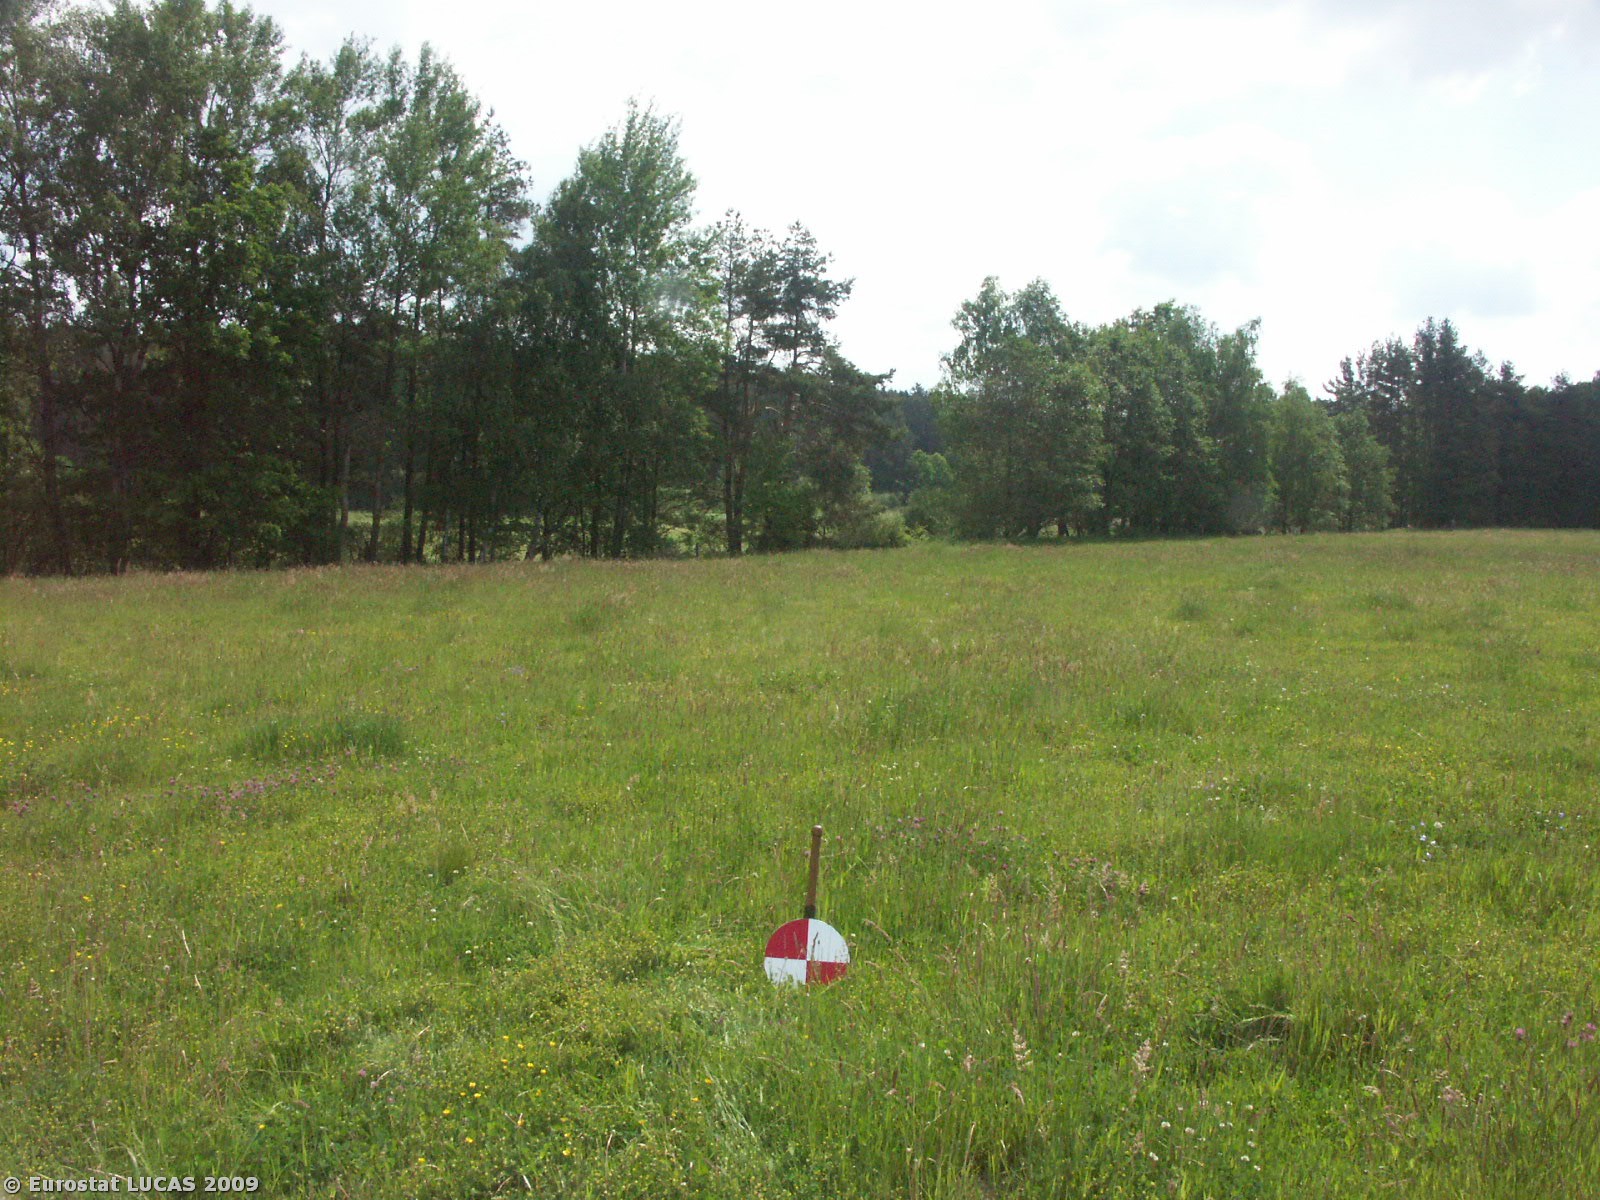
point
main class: Grassland
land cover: Grassland without tree/shrub cover
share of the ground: > 75 %
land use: Agriculture (excluding fallow land and kitchen gardens)
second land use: Nature reserves
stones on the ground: < 10 %
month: May
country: CZ
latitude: 48.8945
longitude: 14.7892
